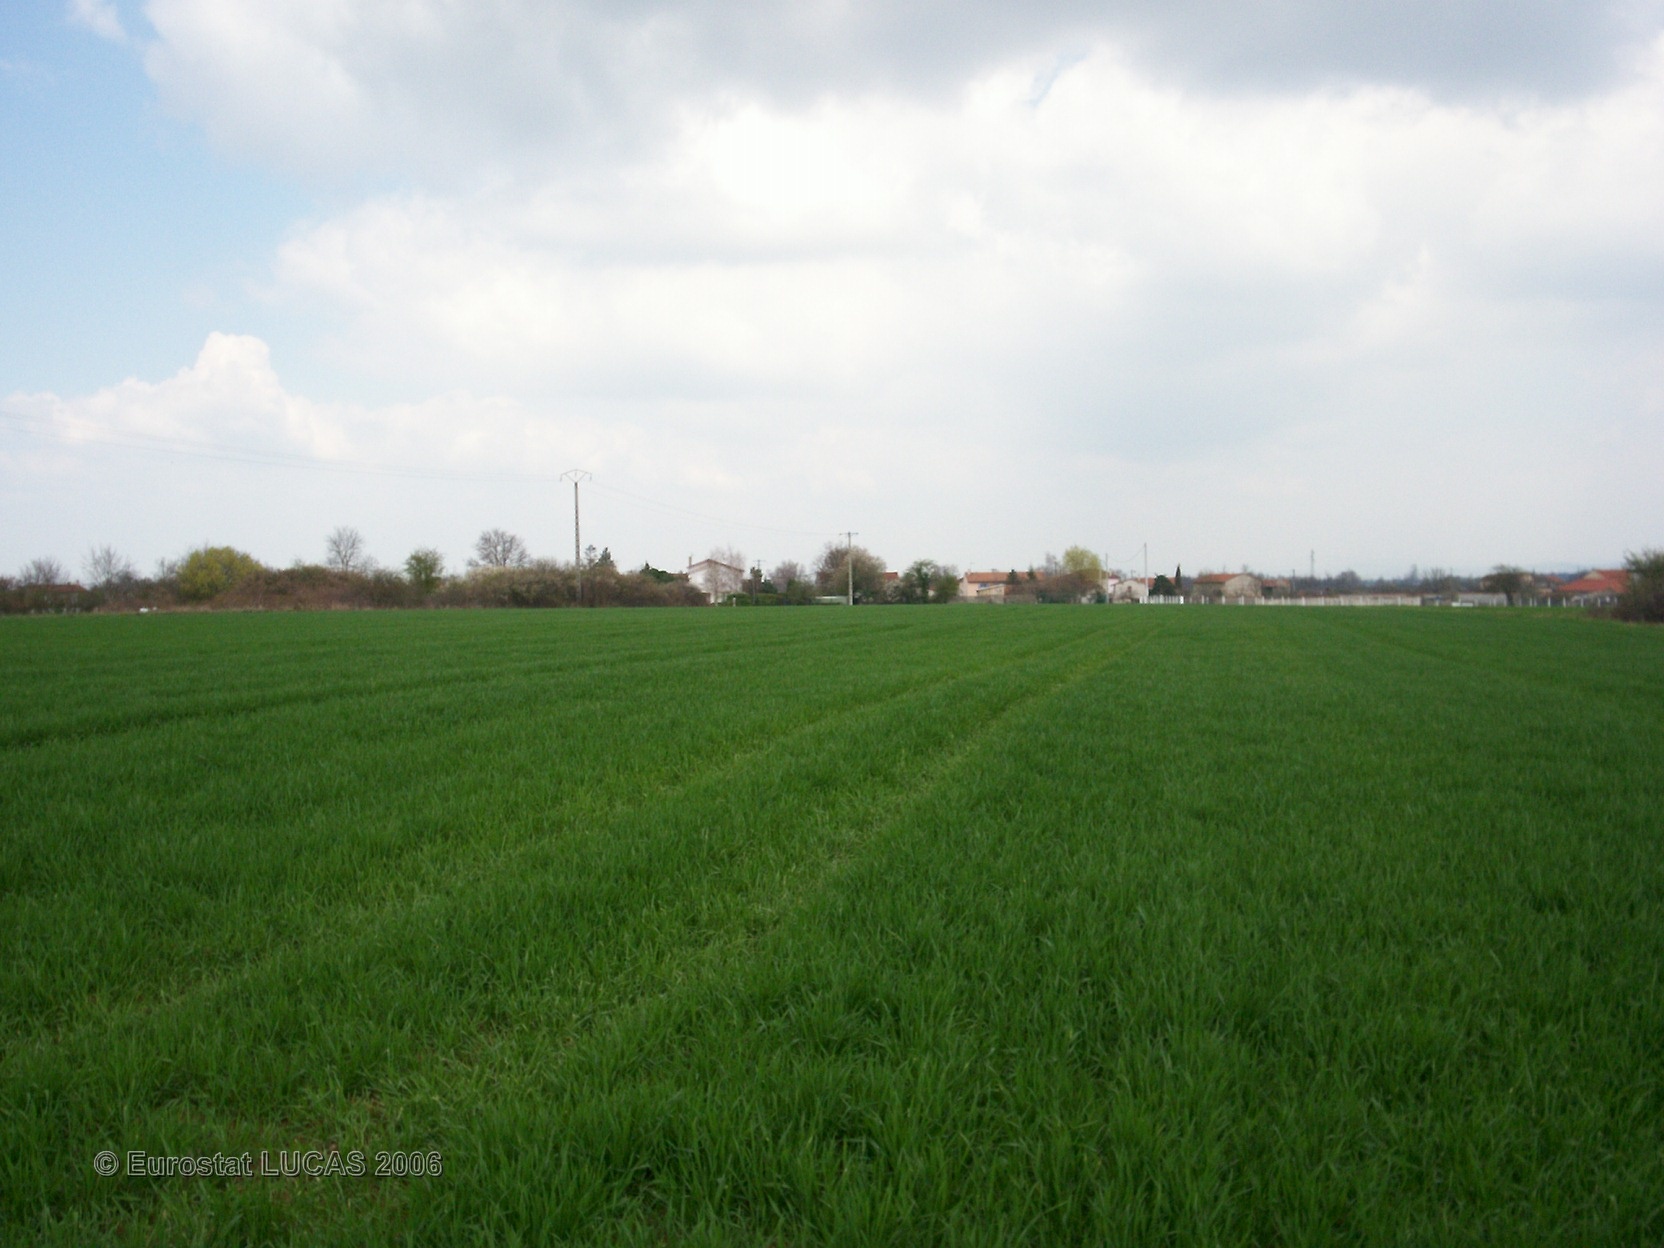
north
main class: Cropland
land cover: Common wheat
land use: Agriculture (excluding fallow land and kitchen gardens)
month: April
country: FR
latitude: 45.5437
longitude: 4.2014
